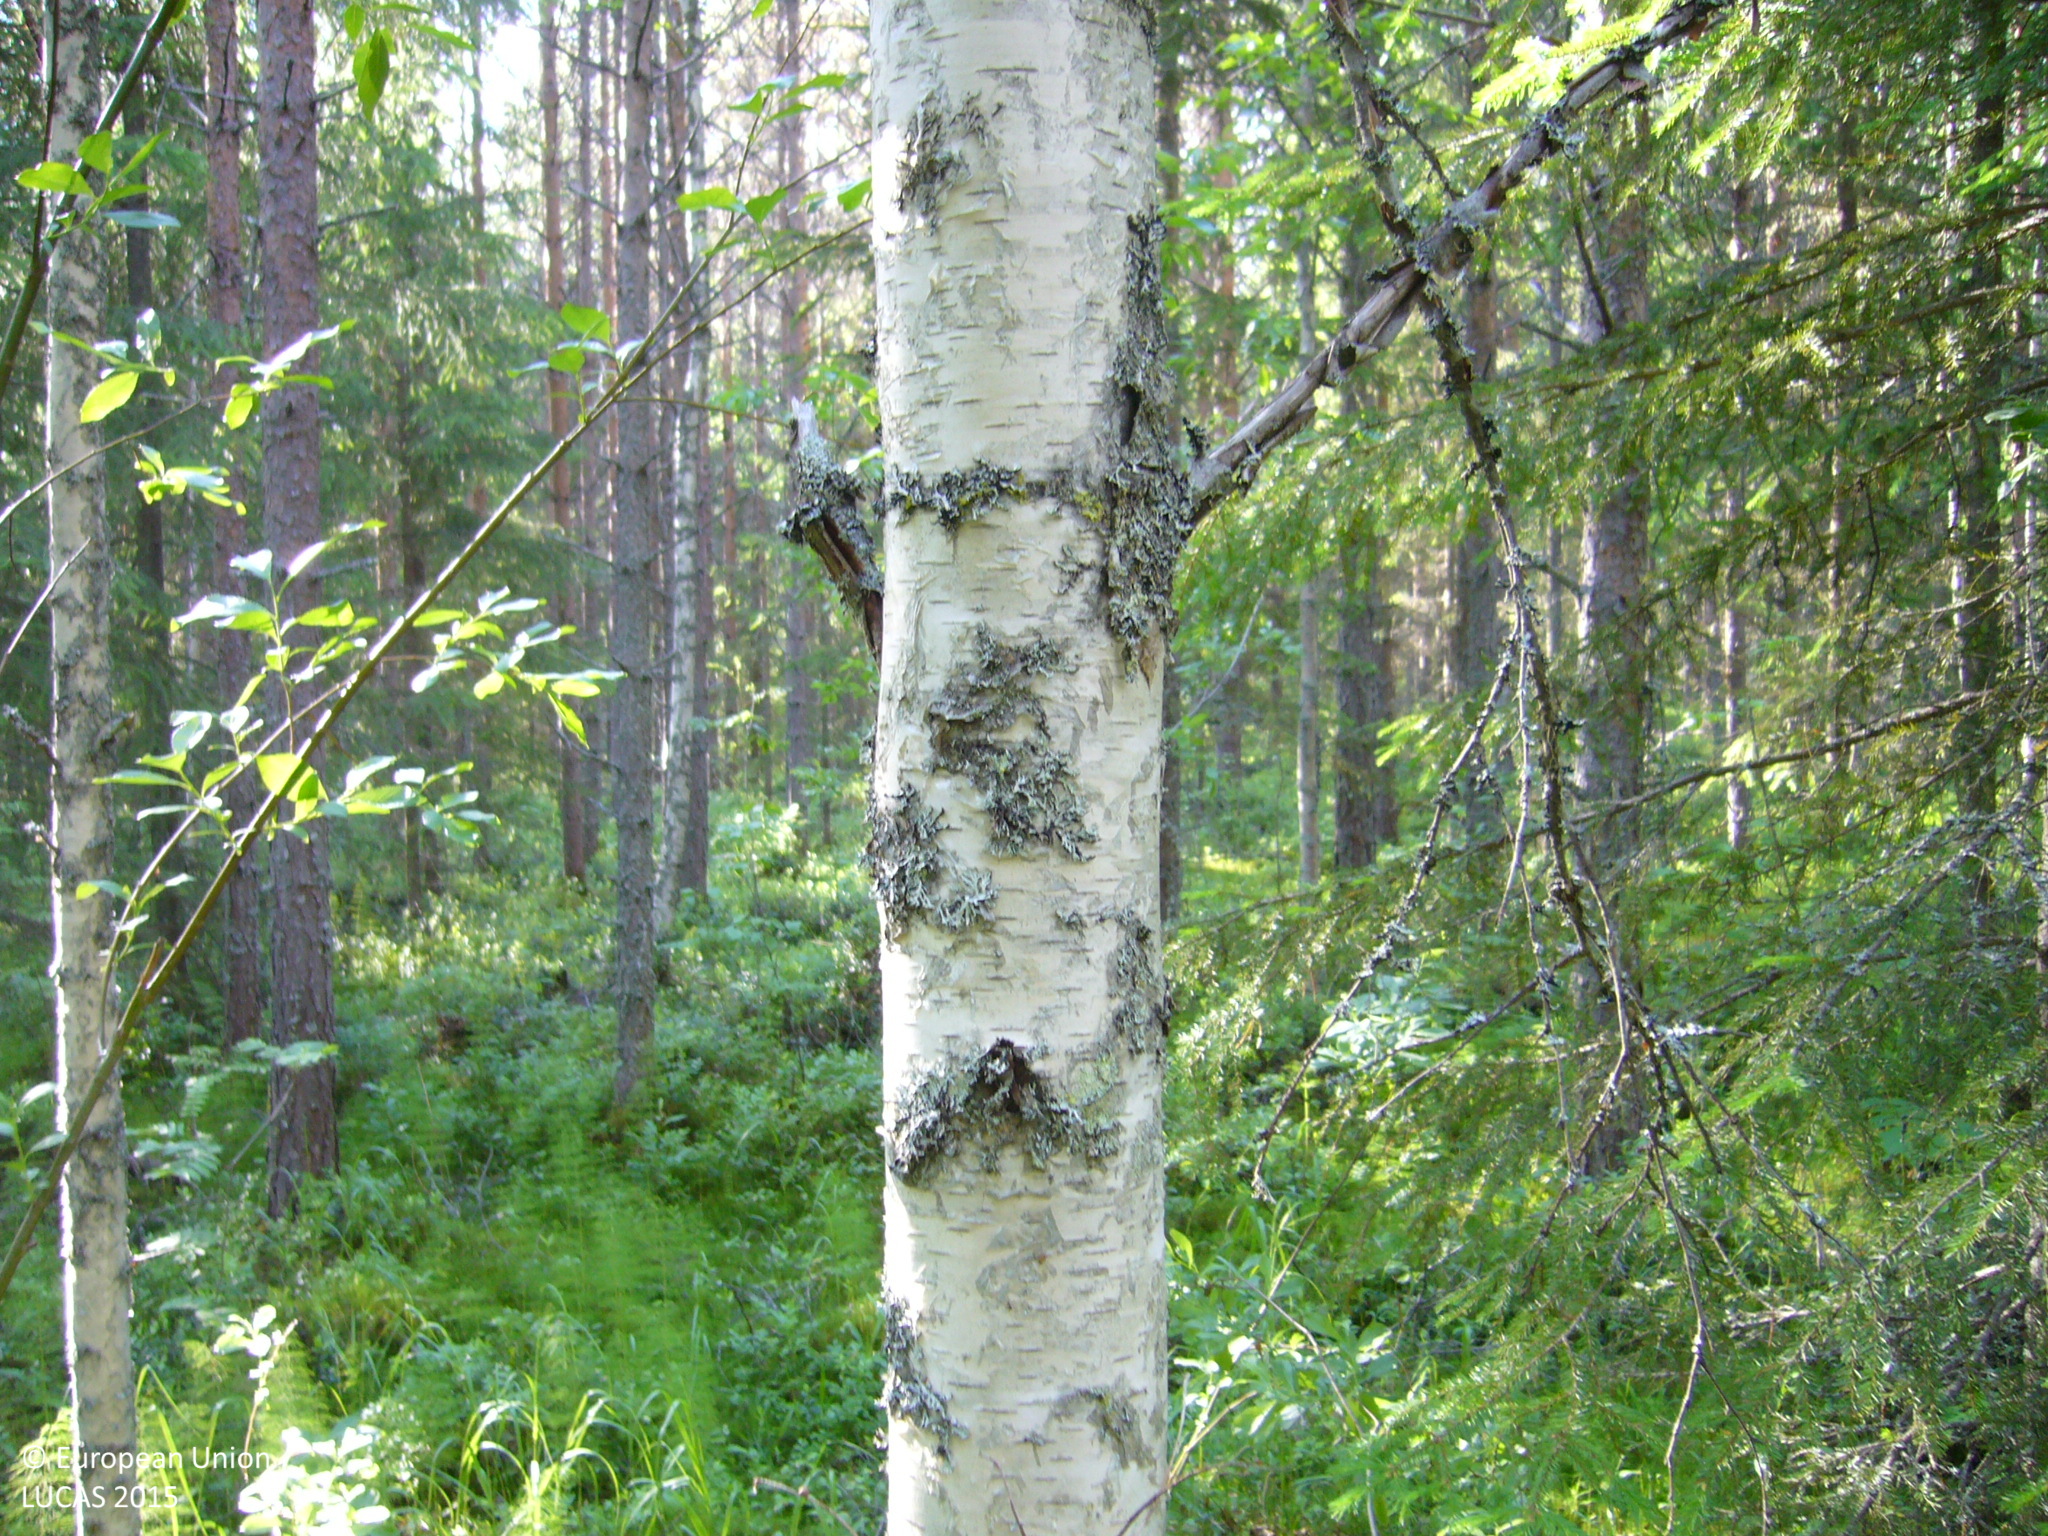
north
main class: Woodland
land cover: Spruce dominated mixed woodland
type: boreal forest
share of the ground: > 75 %
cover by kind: coniferous forest trees 50 %, broadleaved forest trees 40 %, shrubs 10 %
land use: Forestry
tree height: > 5 m
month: July
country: FI
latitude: 63.5015
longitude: 26.3751
